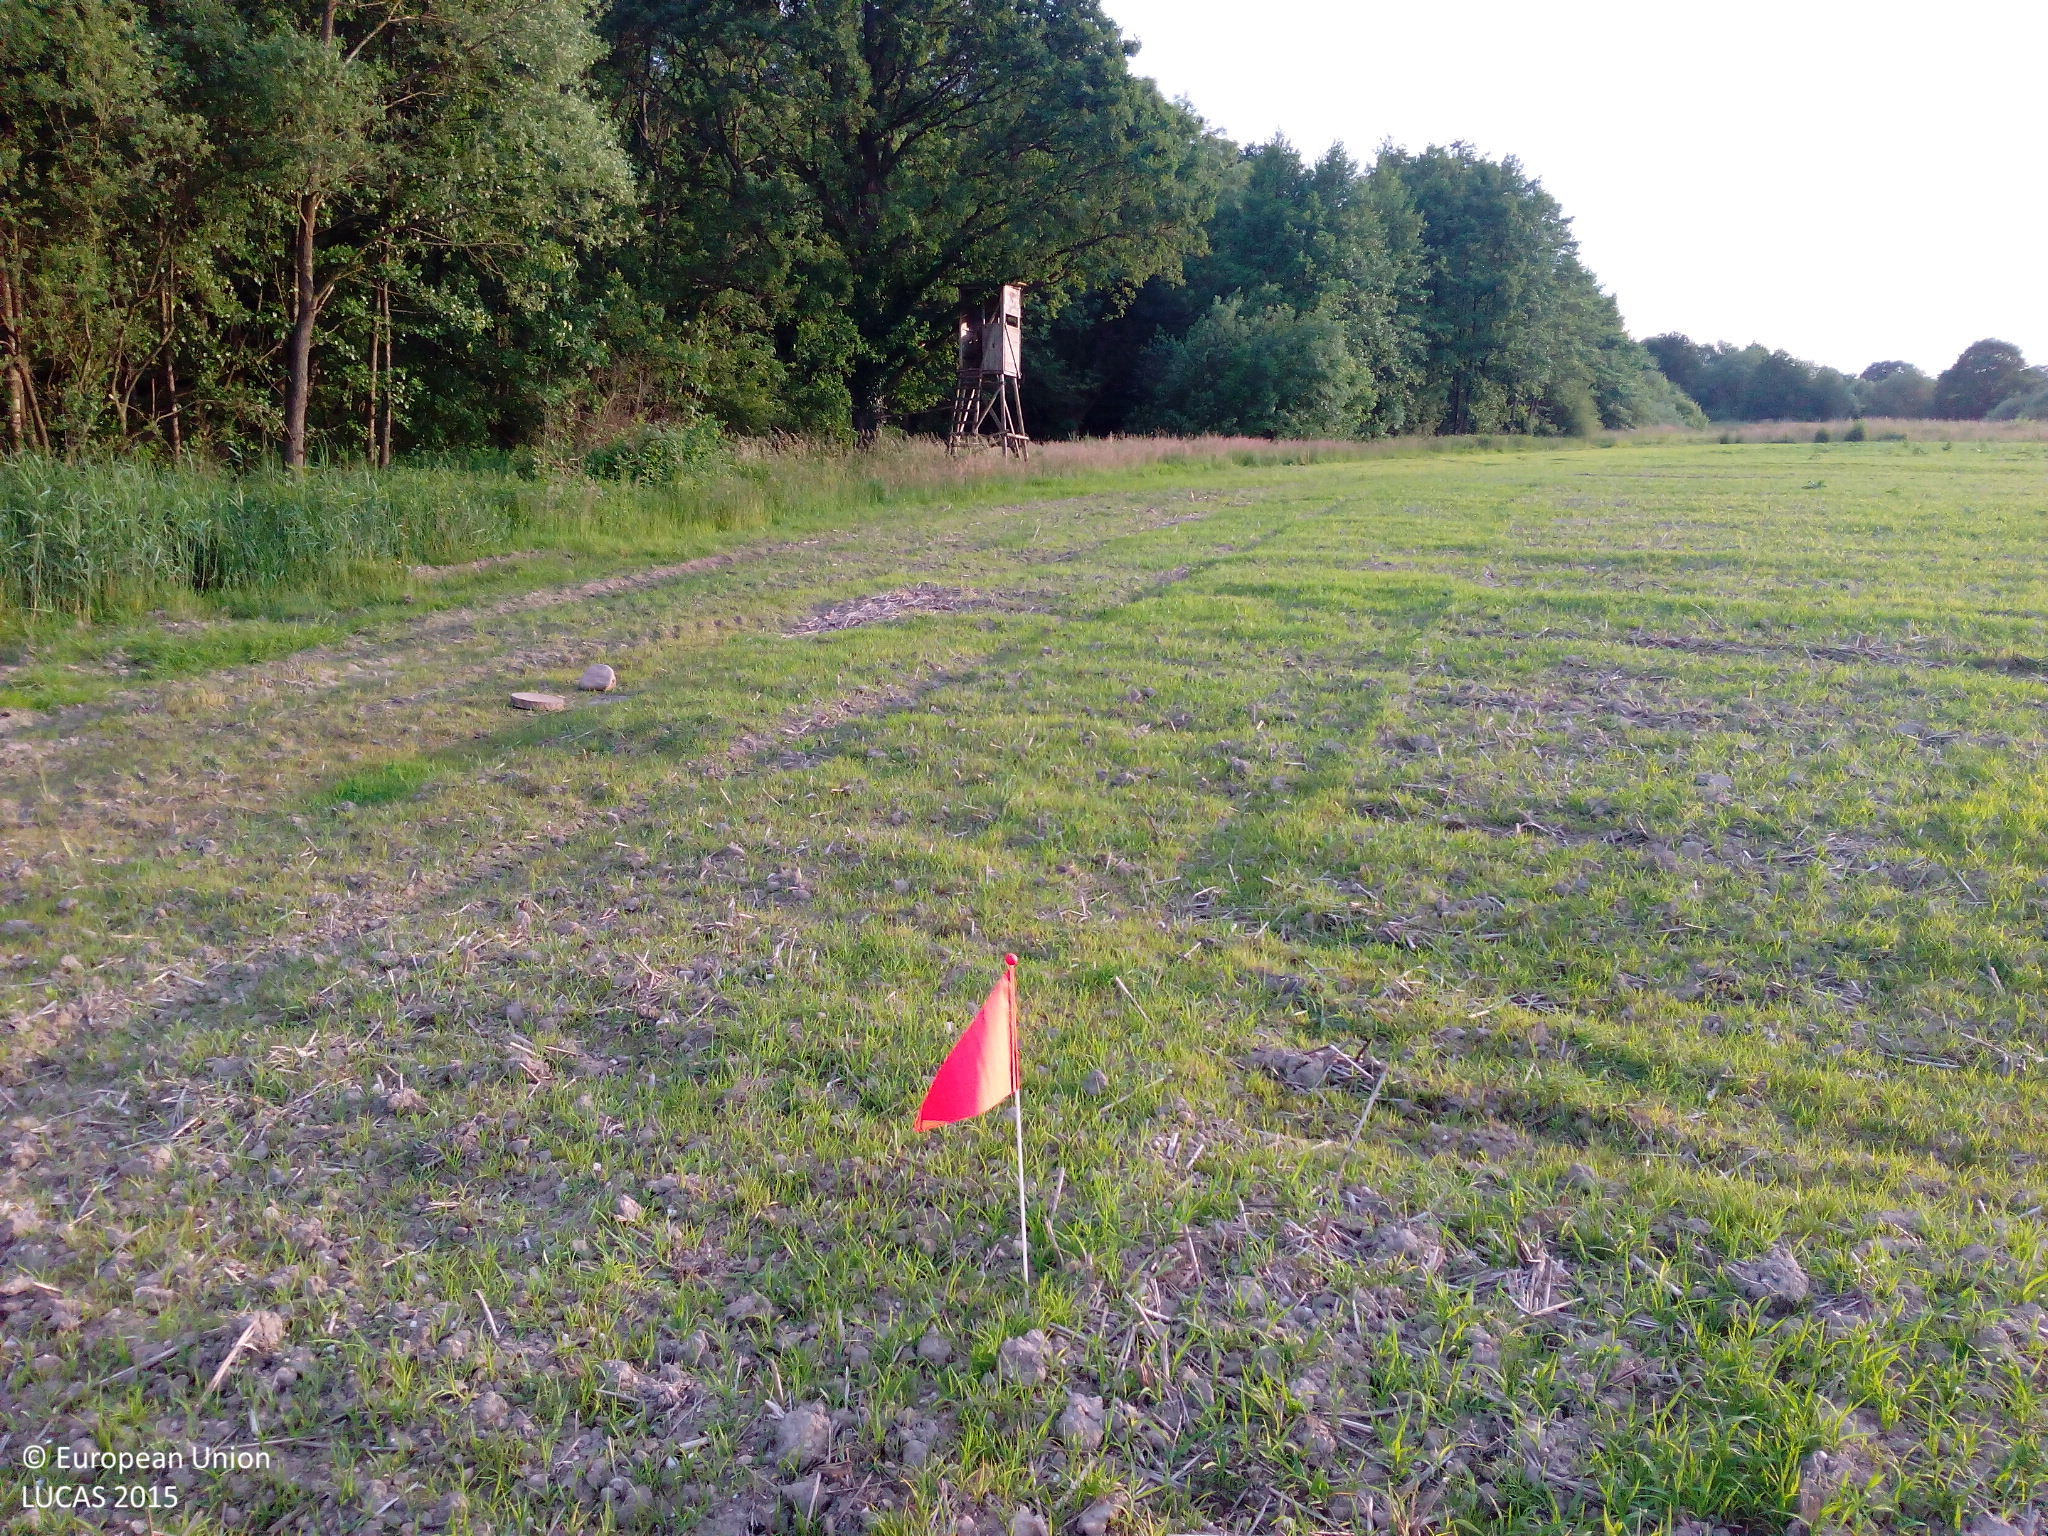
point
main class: Cropland
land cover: Temporary grasslands
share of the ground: 25 - 50 %
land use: Agriculture (excluding fallow land and kitchen gardens)
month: May
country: DE
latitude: 49.0184
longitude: 8.1820
